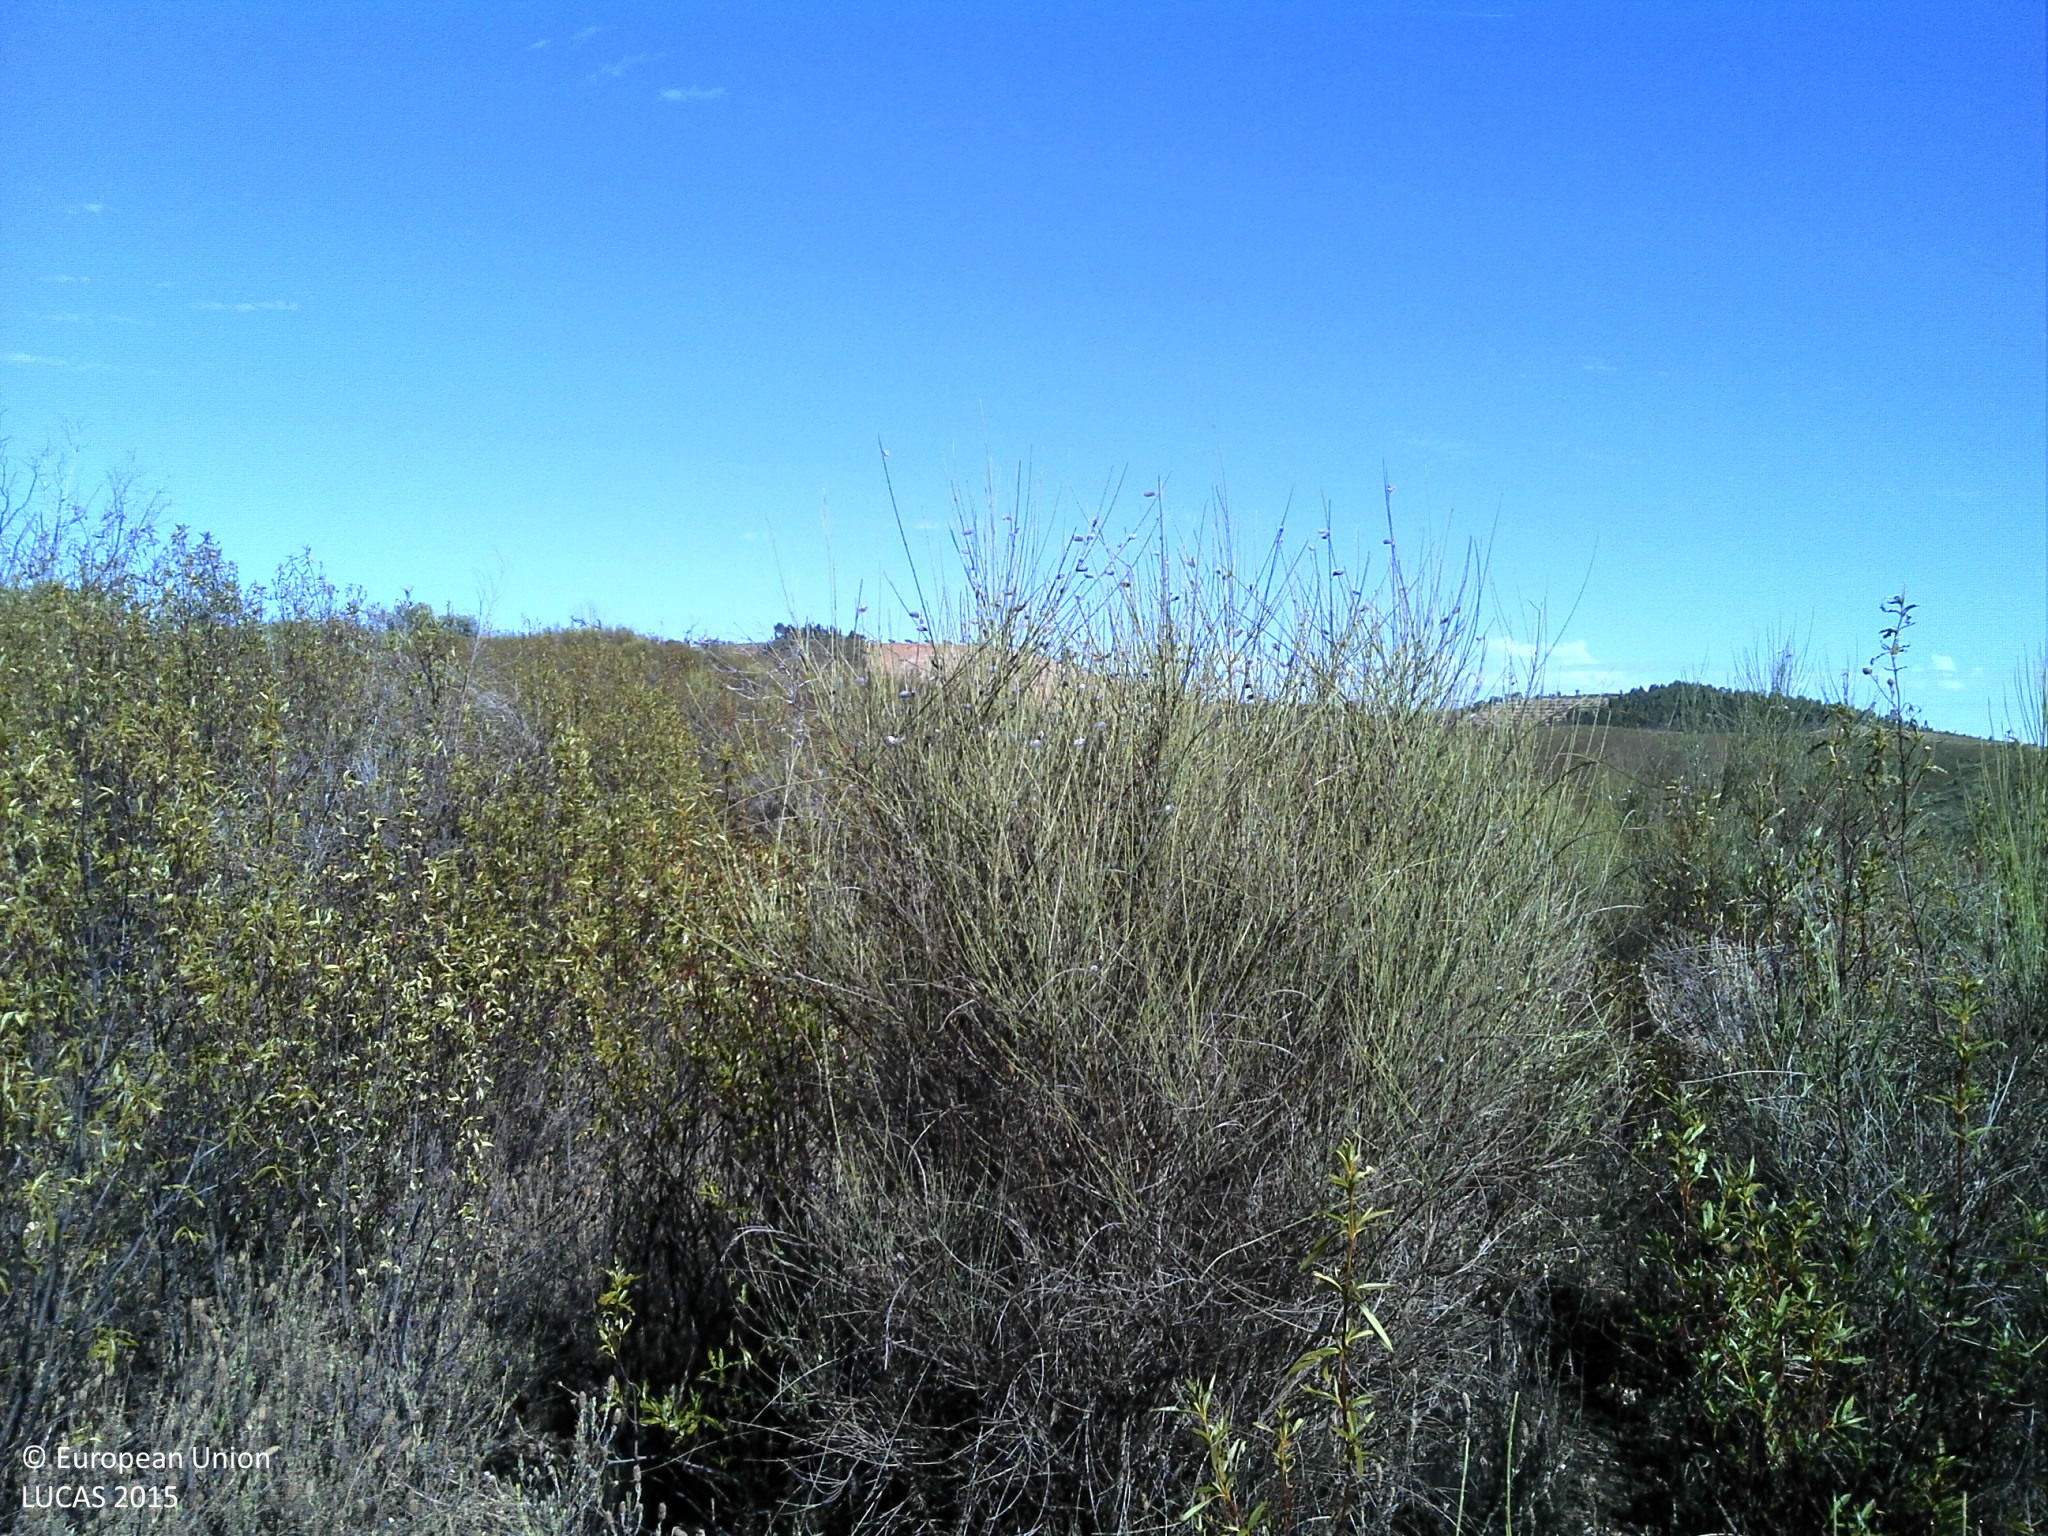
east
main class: Shrubland
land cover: Shrubland without tree cover
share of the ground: > 75 %
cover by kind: shrubs 100 %
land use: Semi-natural and natural areas not in use
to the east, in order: Shrubland without tree cover; Shrubland with sparse tree cover; Shrubland without tree cover
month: August
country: PT
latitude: 39.6252
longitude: -7.5841
